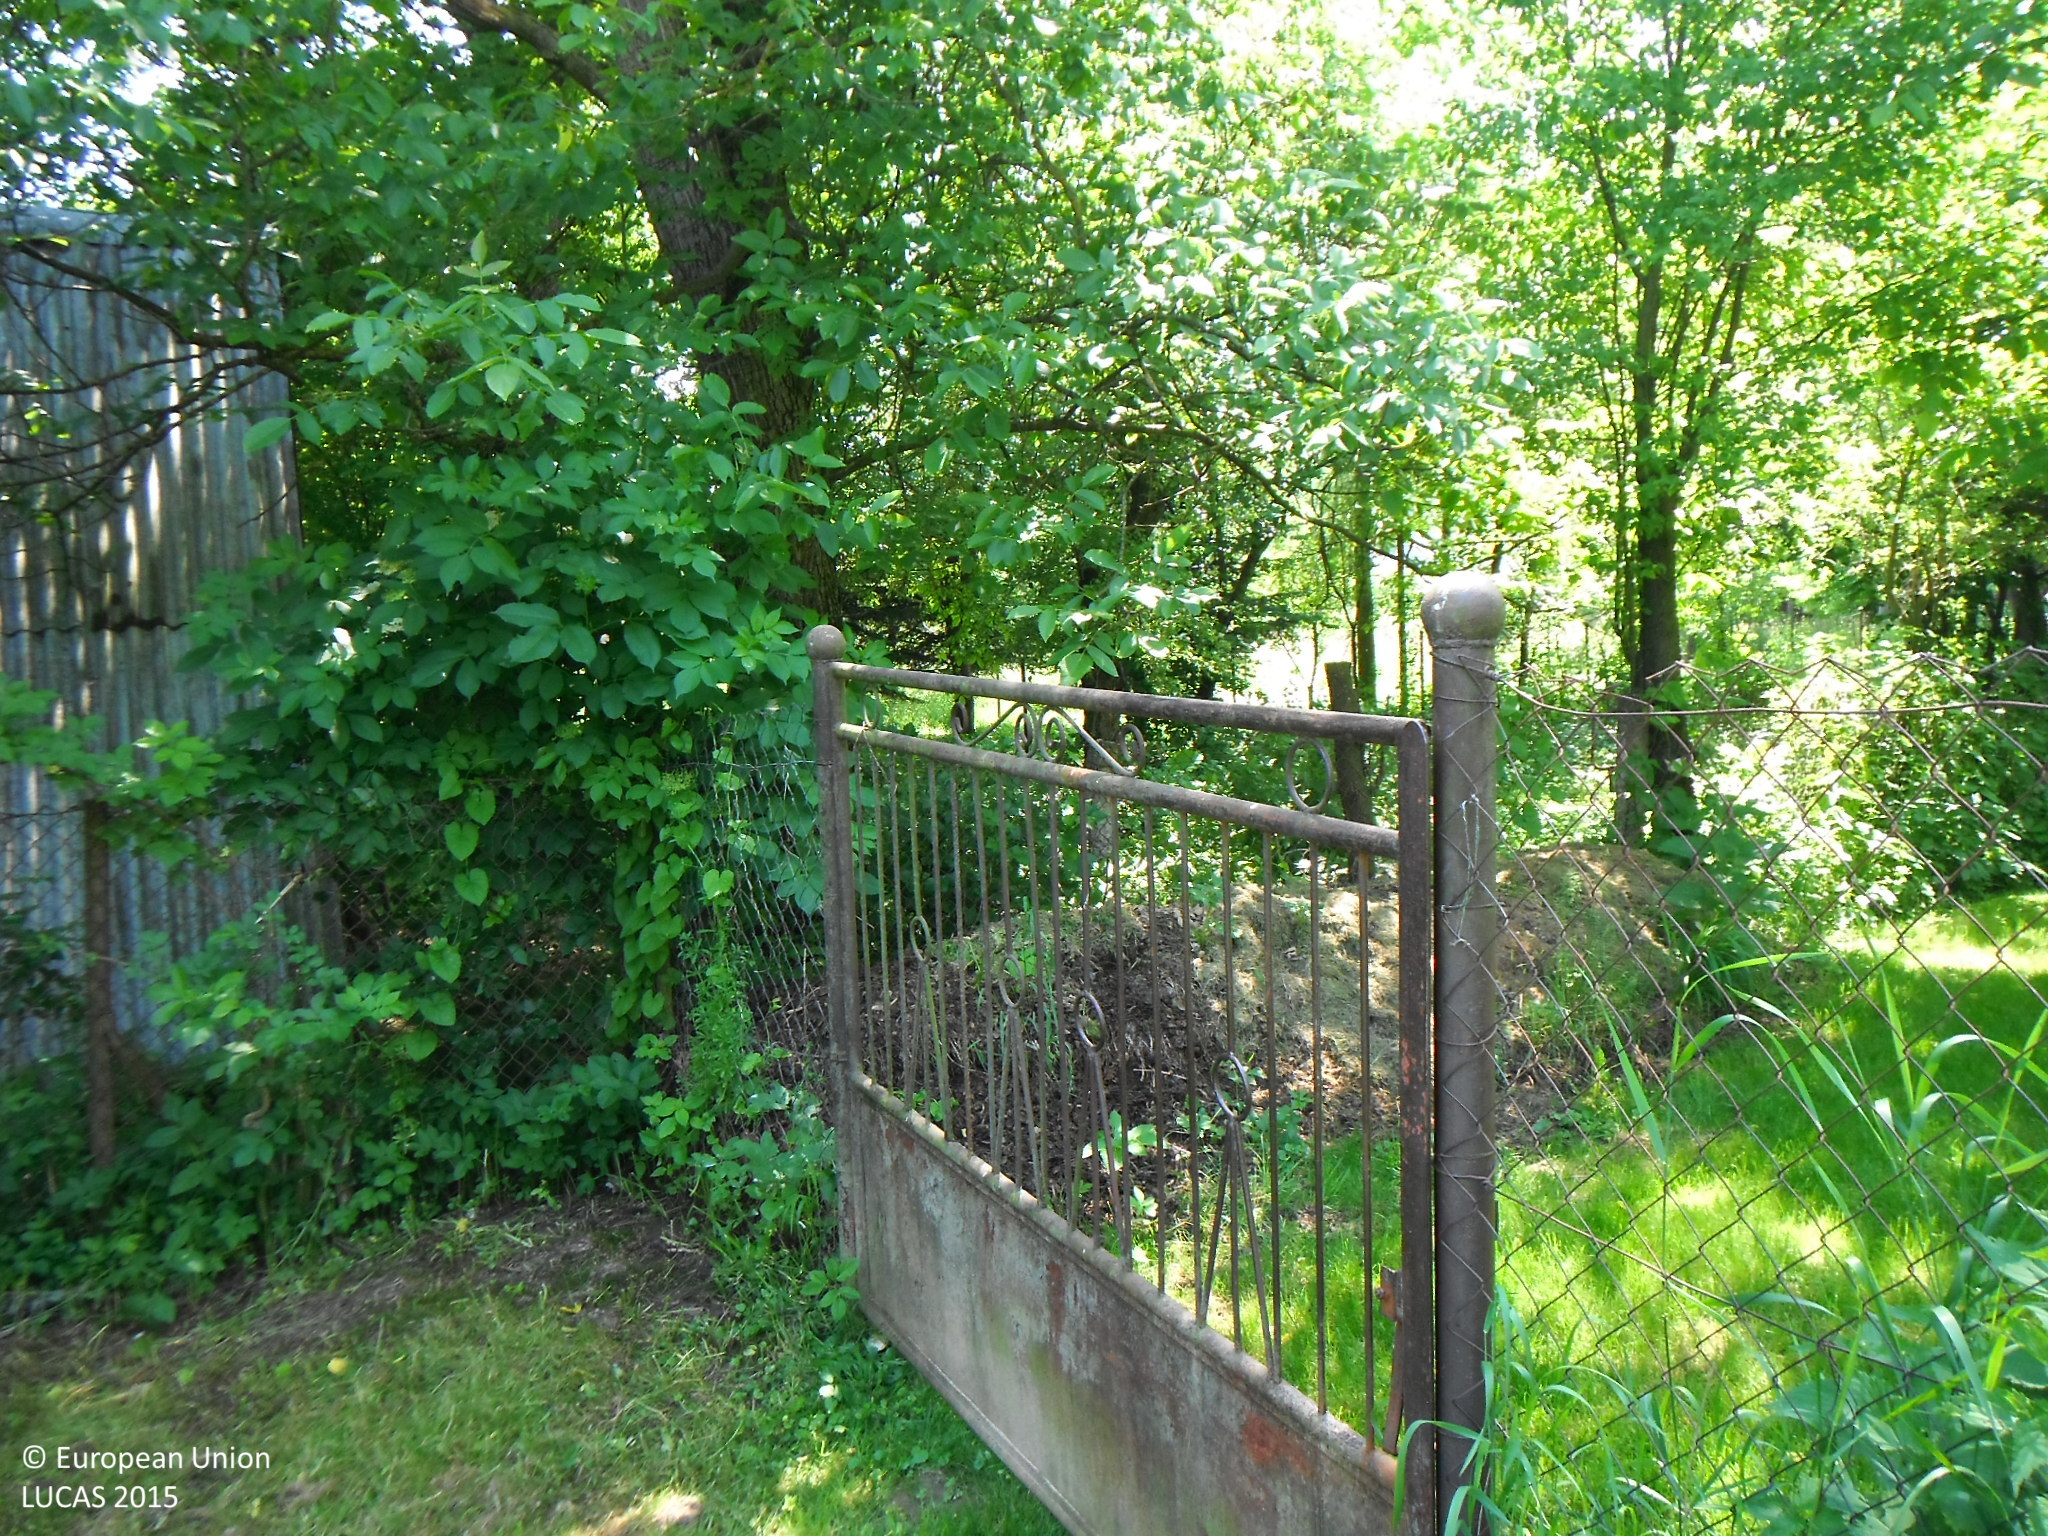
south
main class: Cropland
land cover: Nuts trees
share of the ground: > 75 %
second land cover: Grassland without tree/shrub cover
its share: > 75 %
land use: Kitchen garden
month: June
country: SK
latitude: 48.9932
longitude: 21.5707
